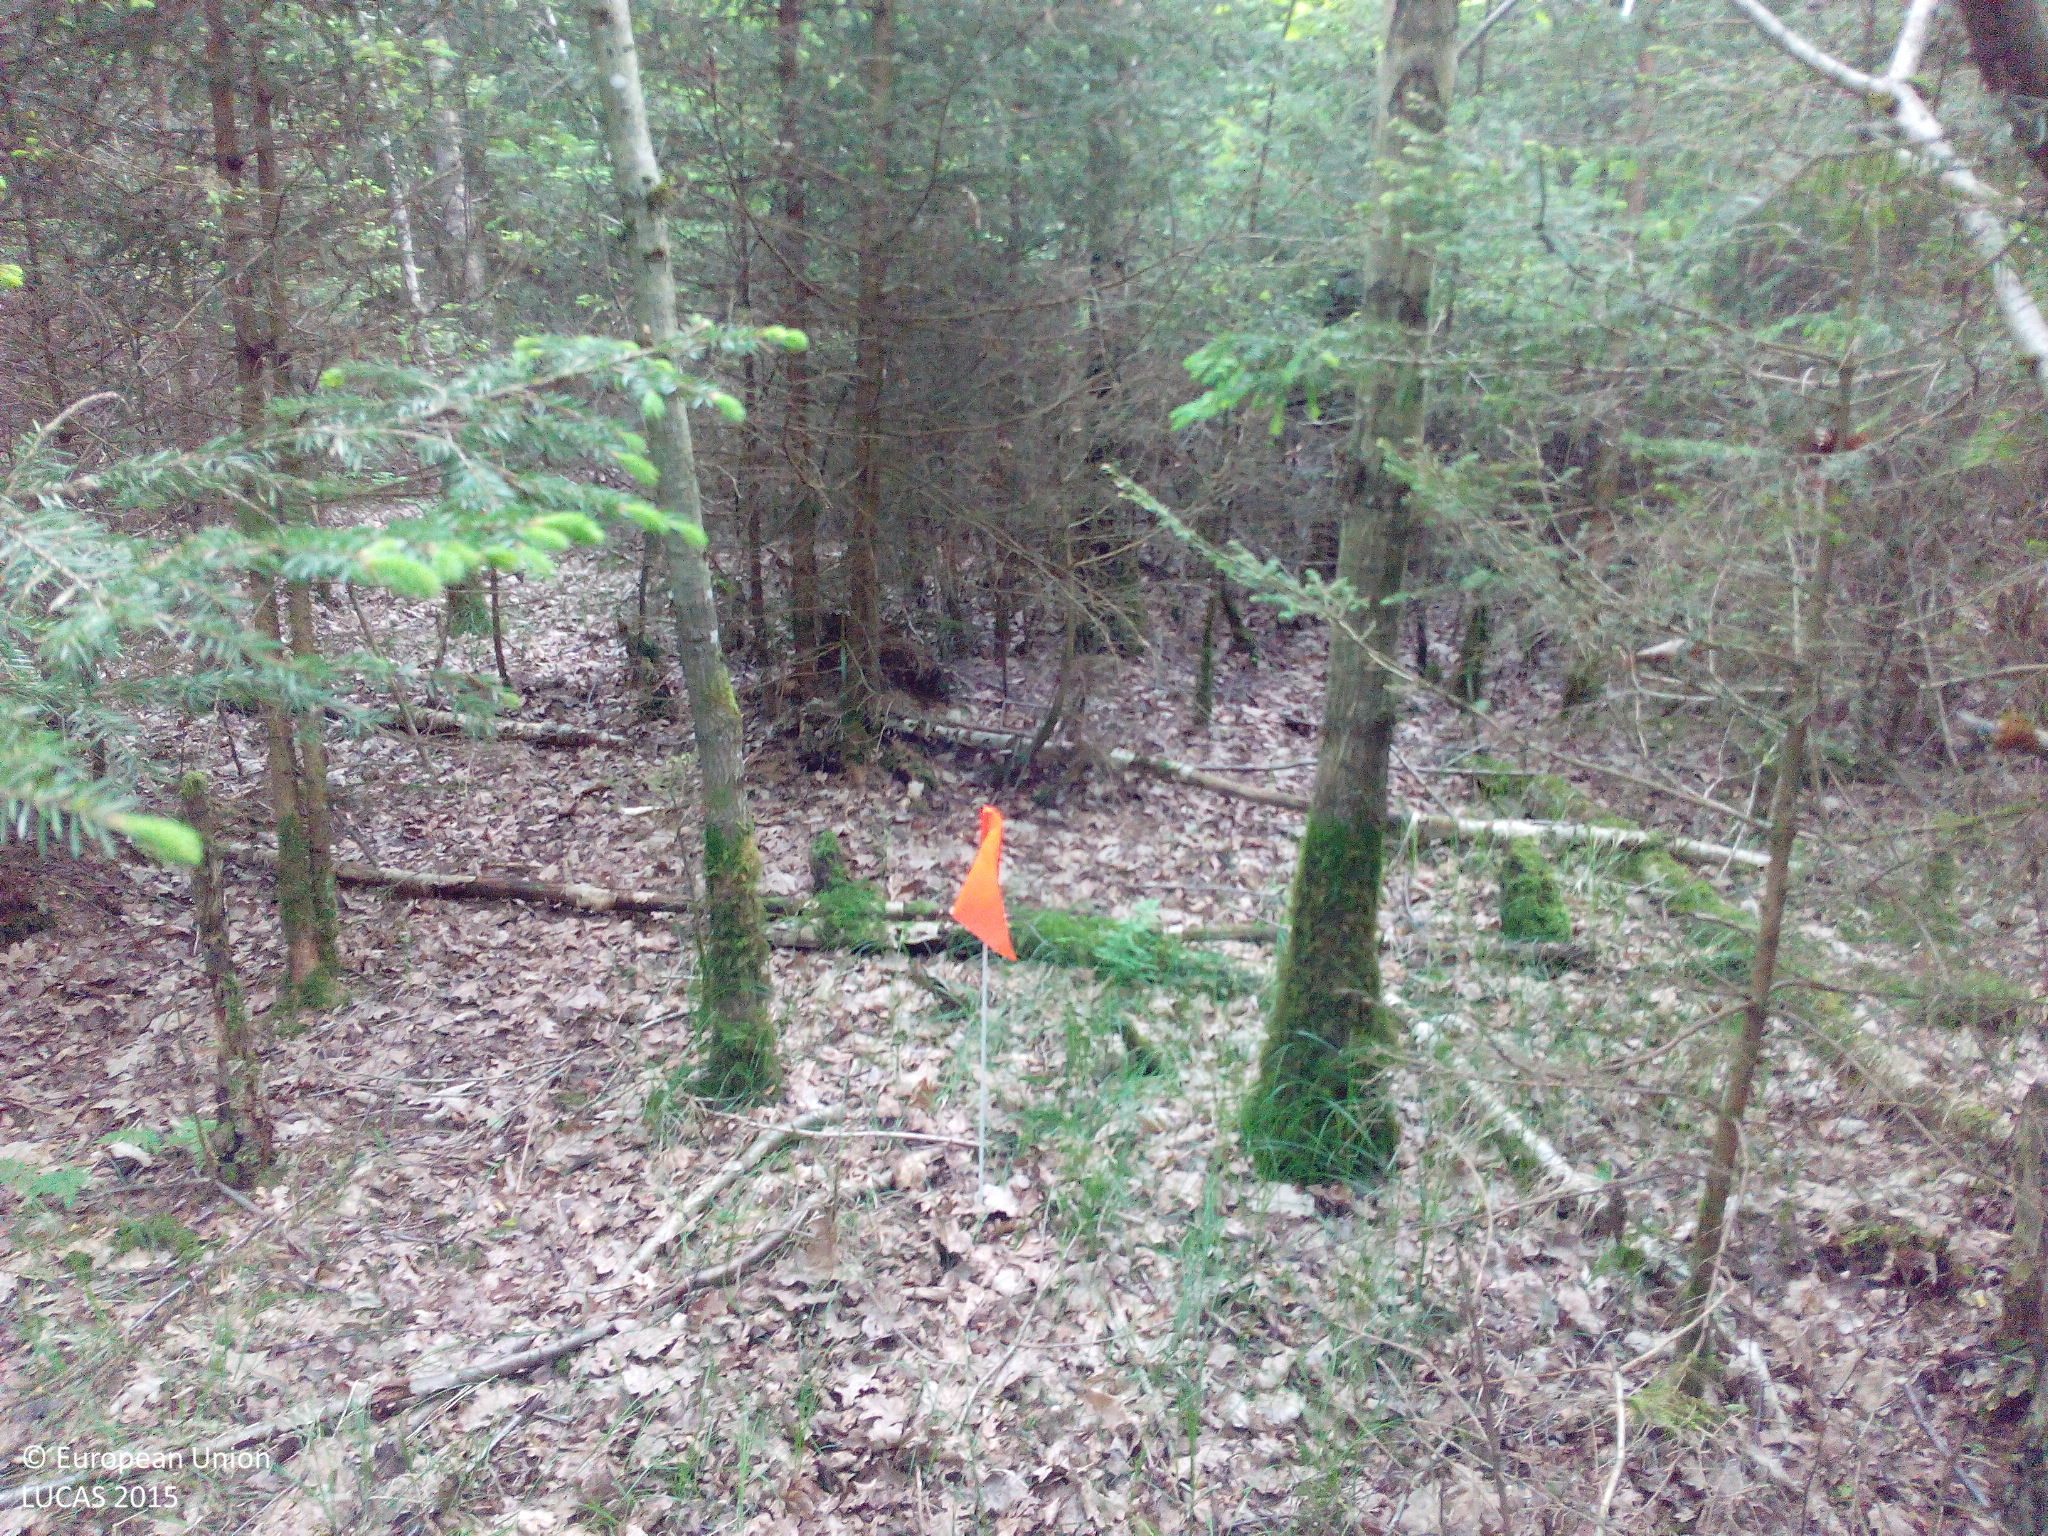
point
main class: Woodland
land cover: Spruce dominated mixed woodland
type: hemiboreal forest and nemoral coniferous forest and mixed broadleaved-coniferous forest
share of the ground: > 75 %
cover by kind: coniferous forest trees 70 %, broadleaved forest trees 30 %
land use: Forestry
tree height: > 5 m
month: May
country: DE
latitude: 48.2232
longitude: 10.2556
